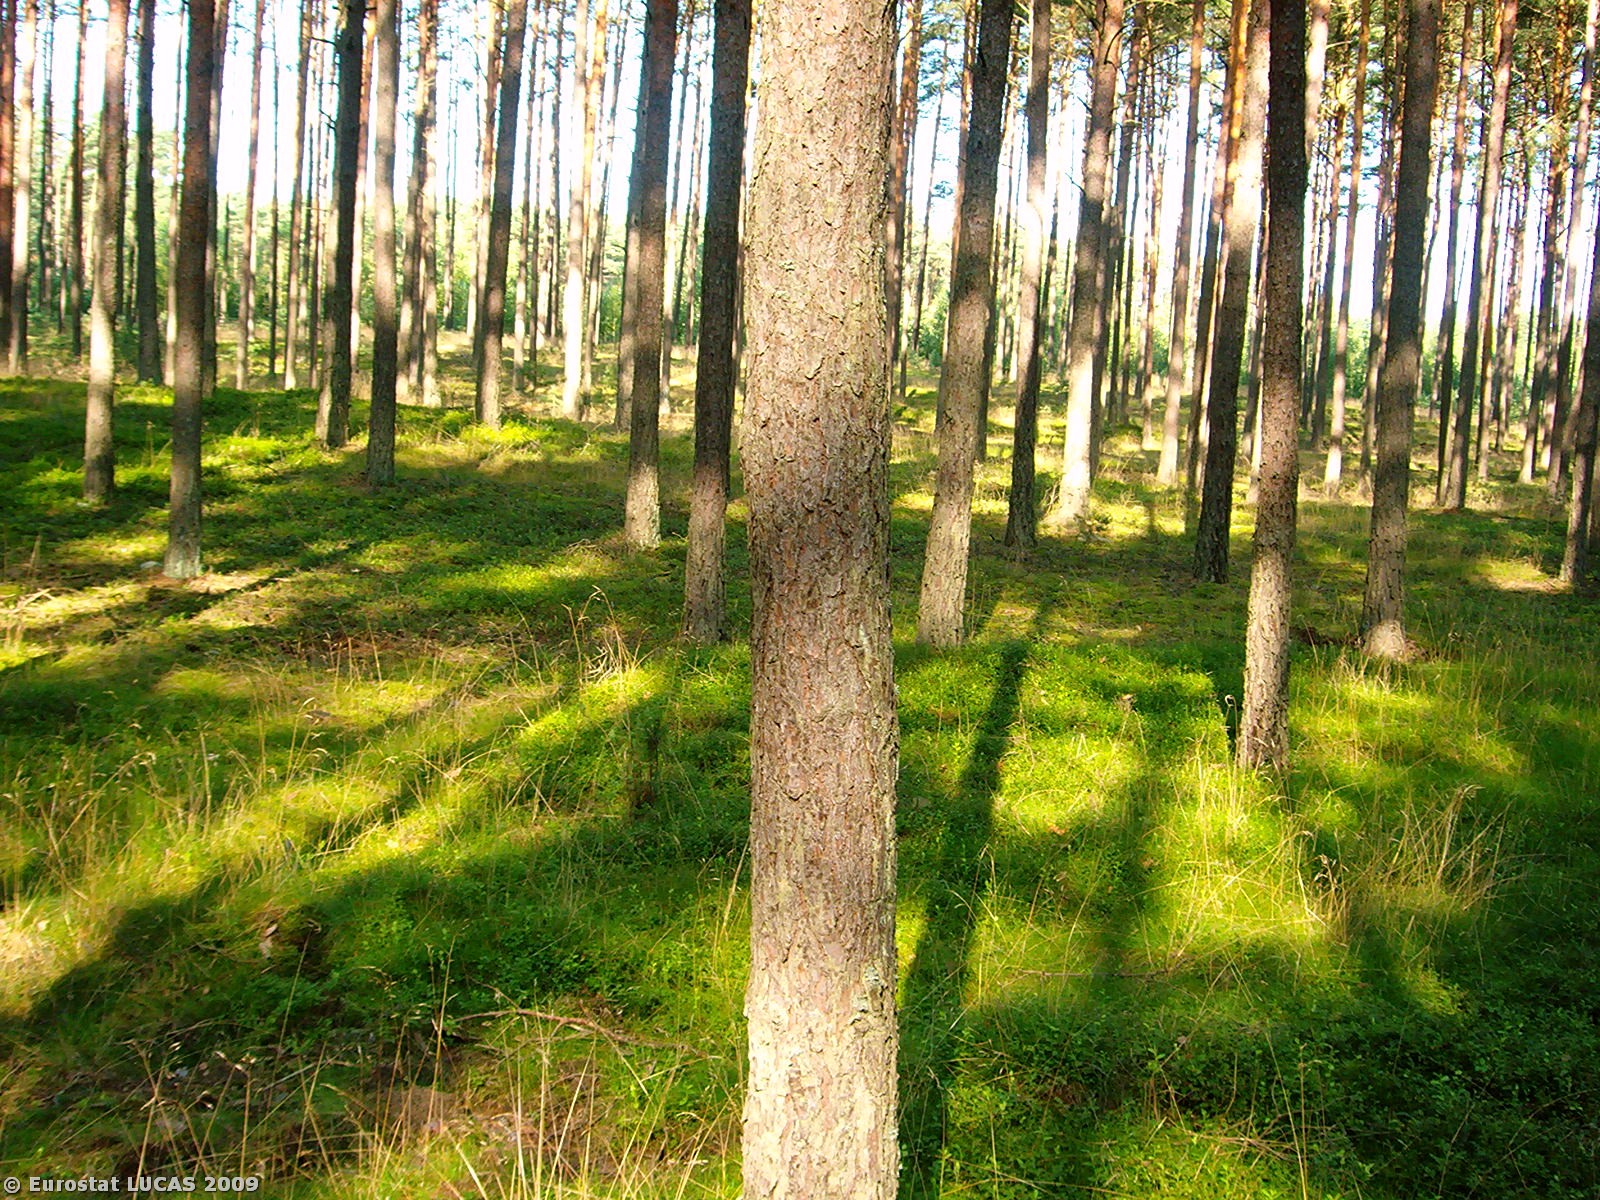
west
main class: Woodland
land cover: Coniferous woodland
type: hemiboreal forest and nemoral coniferous forest and mixed broadleaved-coniferous forest
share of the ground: 50 - 75 %
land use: Forestry
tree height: > 5 m
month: August
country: PL
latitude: 52.8794
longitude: 15.9041
